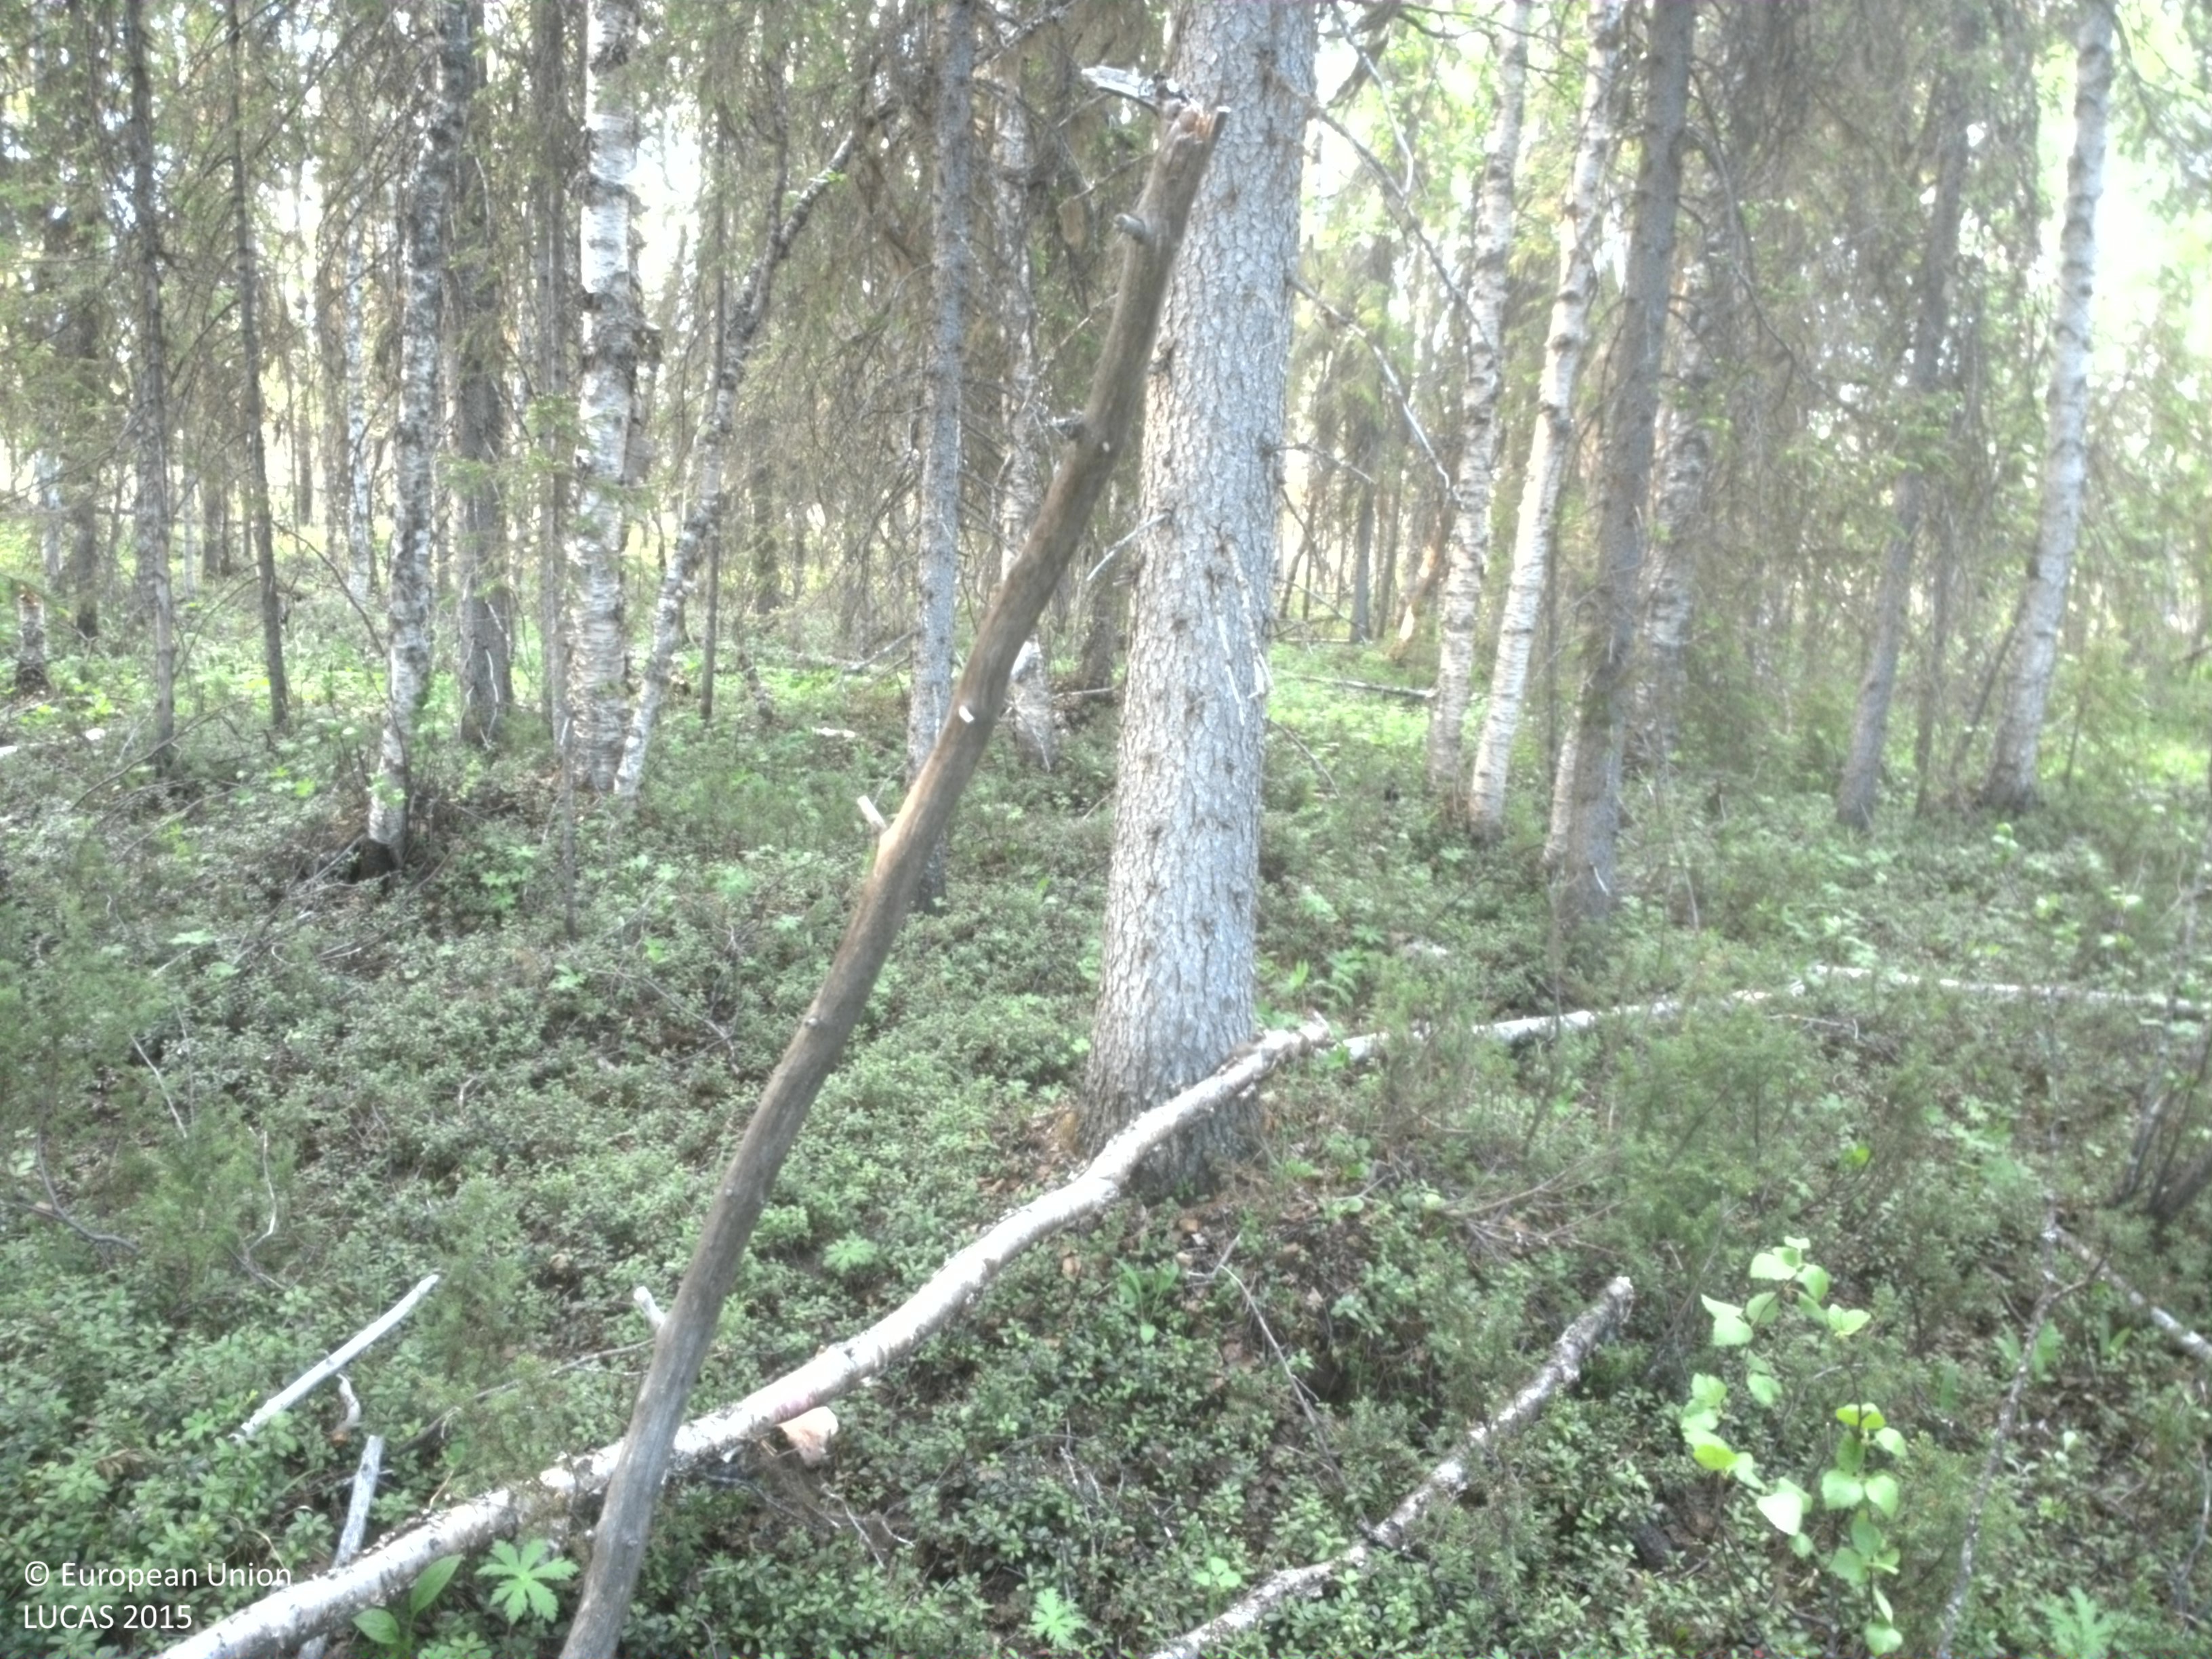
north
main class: Woodland
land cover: Spruce dominated mixed woodland
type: boreal forest
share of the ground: 50 - 75 %
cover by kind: shrubs 45 %, coniferous forest trees 35 %, broadleaved forest trees 15 %, herbaceous plants 5 %
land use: Forestry
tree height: > 5 m
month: June
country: SE
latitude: 67.0991
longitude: 21.6777
